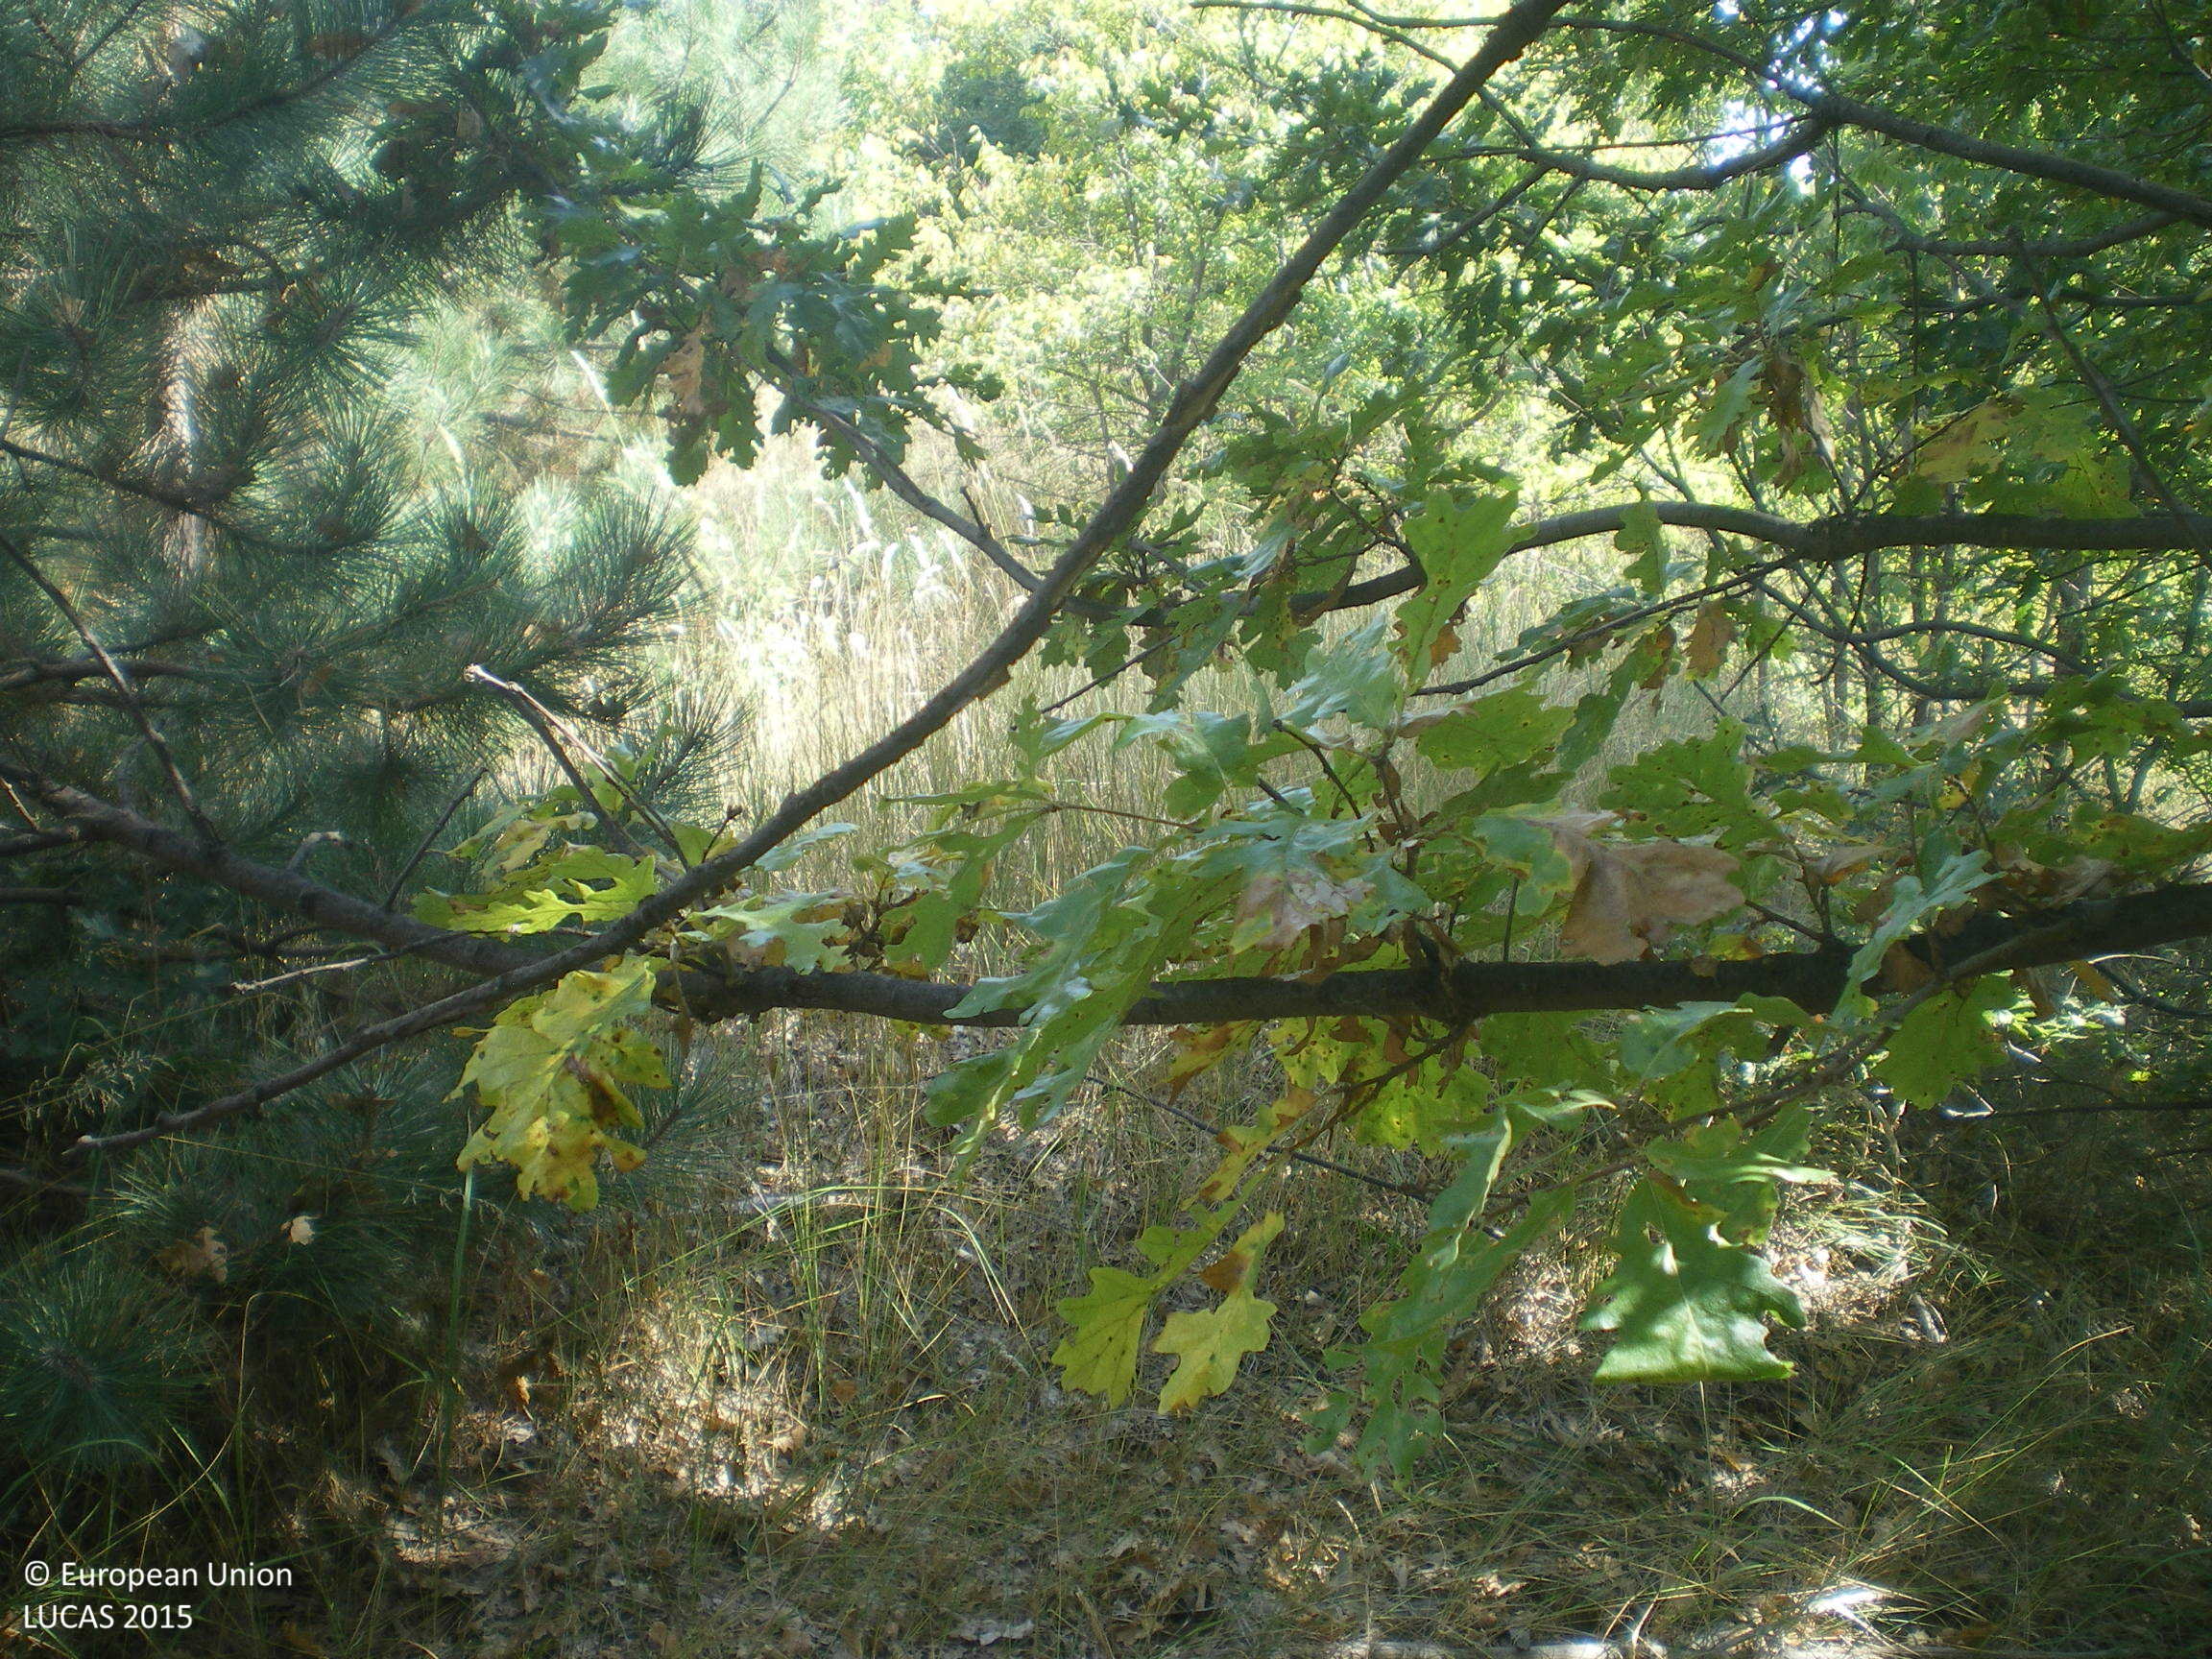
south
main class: Woodland
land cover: Broadleaved woodland
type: mesophytic deciduous forest
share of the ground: > 75 %
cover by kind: broadleaved forest trees 90 %, coniferous forest trees 5 %, herbaceous plants 5 %
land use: Residential
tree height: > 5 m
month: September
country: BG
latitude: 42.0527
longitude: 26.1114
